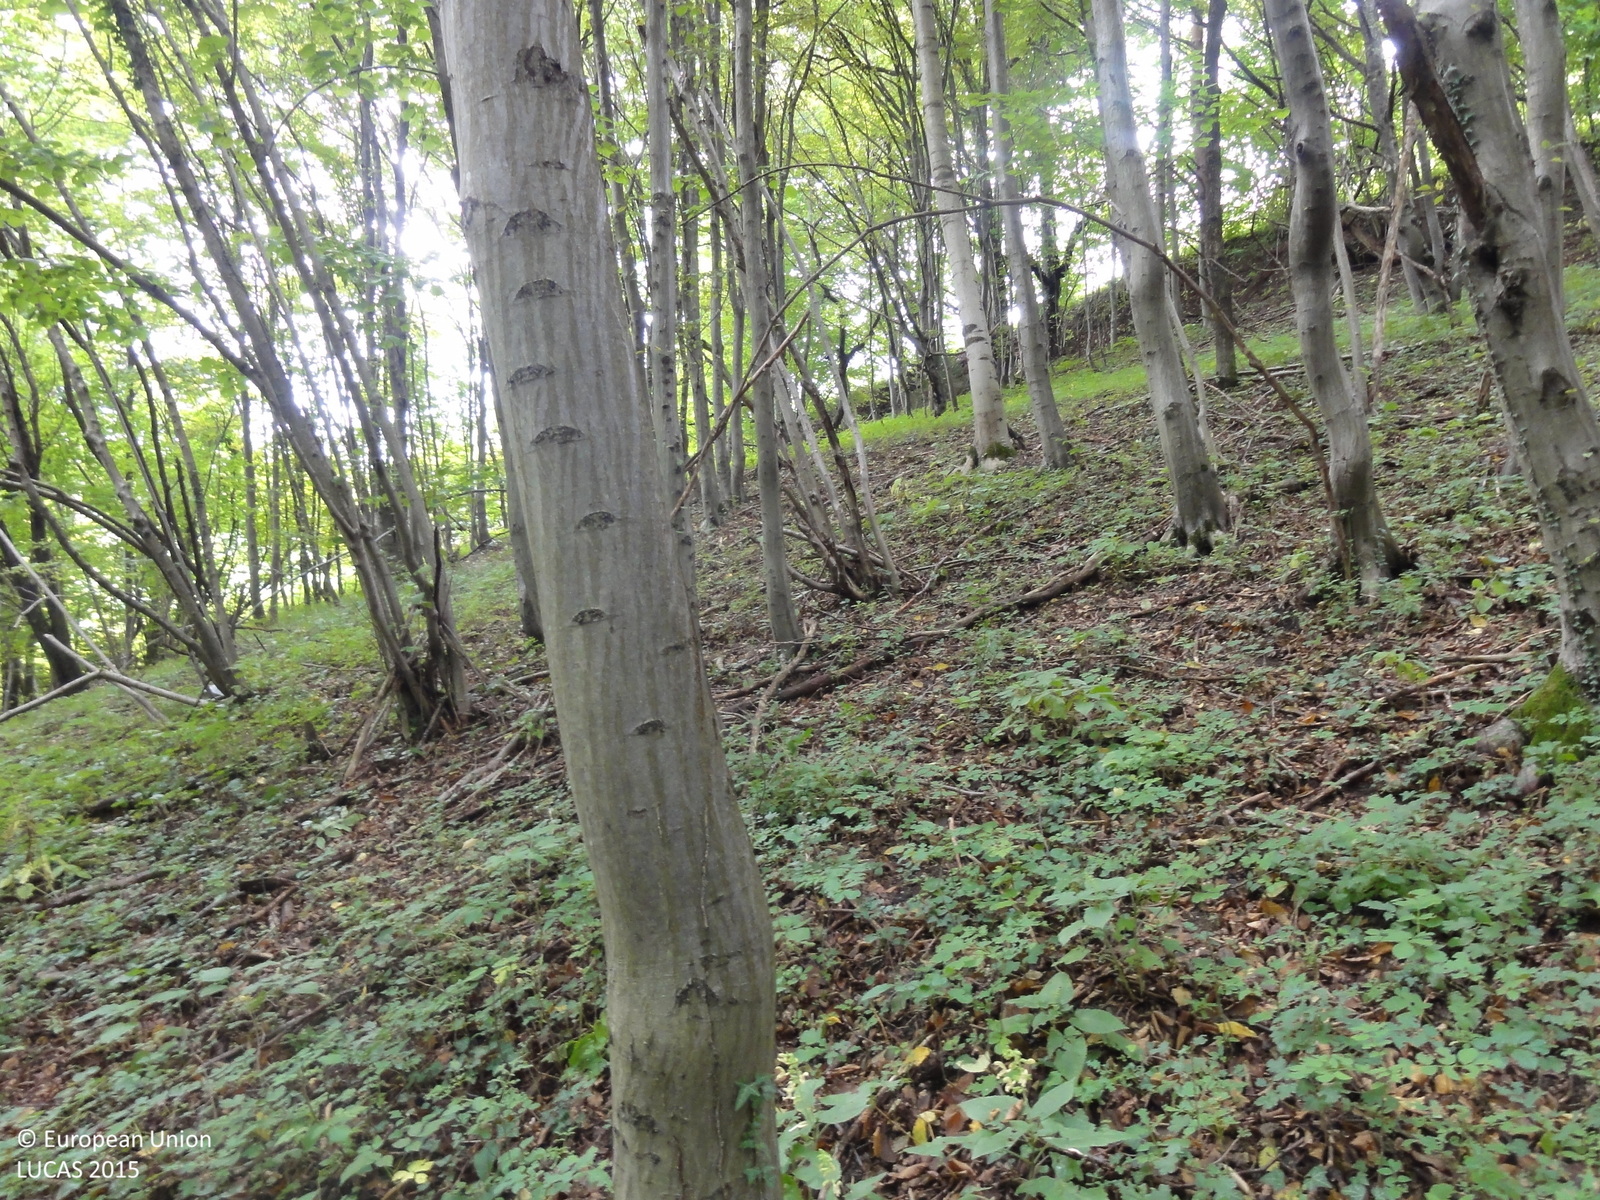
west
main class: Woodland
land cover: Broadleaved woodland
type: mesophytic deciduous forest
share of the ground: > 75 %
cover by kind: broadleaved forest trees 95 %, coniferous forest trees 5 %
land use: Forestry
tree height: > 5 m
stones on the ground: < 10 %
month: August
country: SI
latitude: 46.1605
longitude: 15.0347
